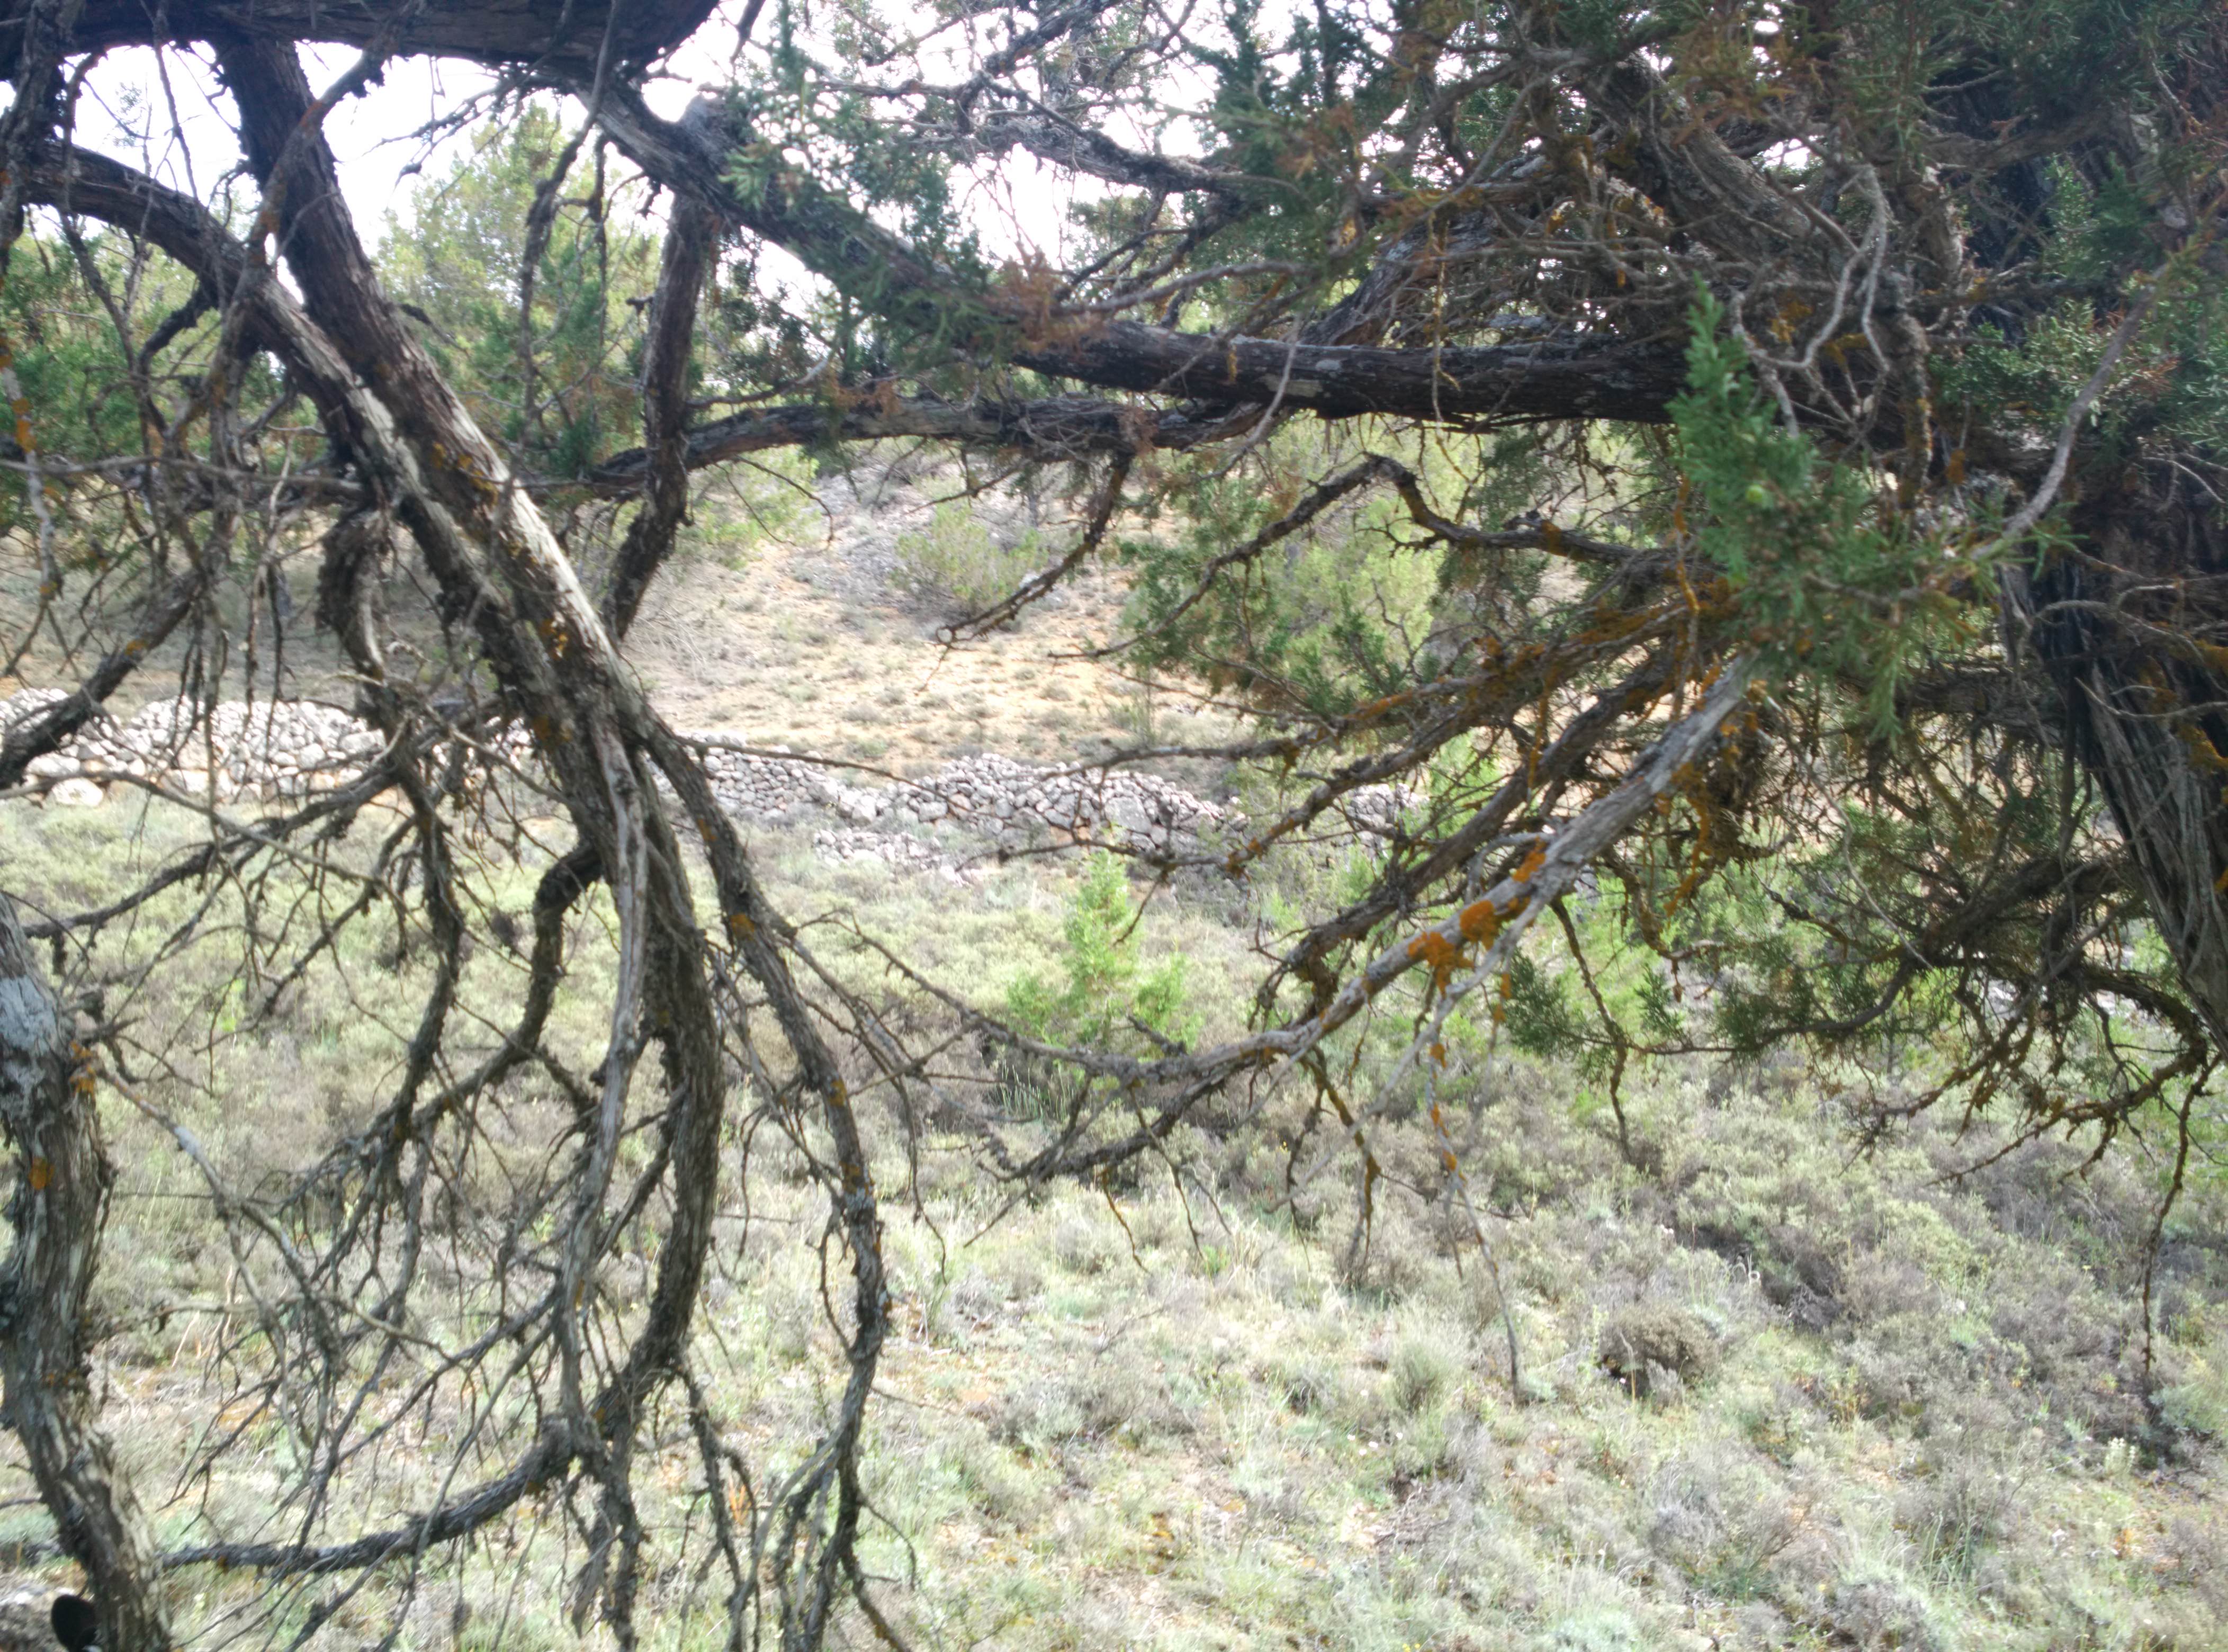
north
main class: Woodland
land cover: Other coniferous woodland
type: coniferous forest of the mediterranean region
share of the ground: 25 - 50 %
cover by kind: herbaceous plants 50 %, coniferous forest trees 30 %, shrubs 10 %, unconsolidated bare surface 10 %
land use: Semi-natural and natural areas not in use
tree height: > 5 m
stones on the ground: 10 - 25 %
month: July
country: ES
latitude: 40.8827
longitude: -1.9740
